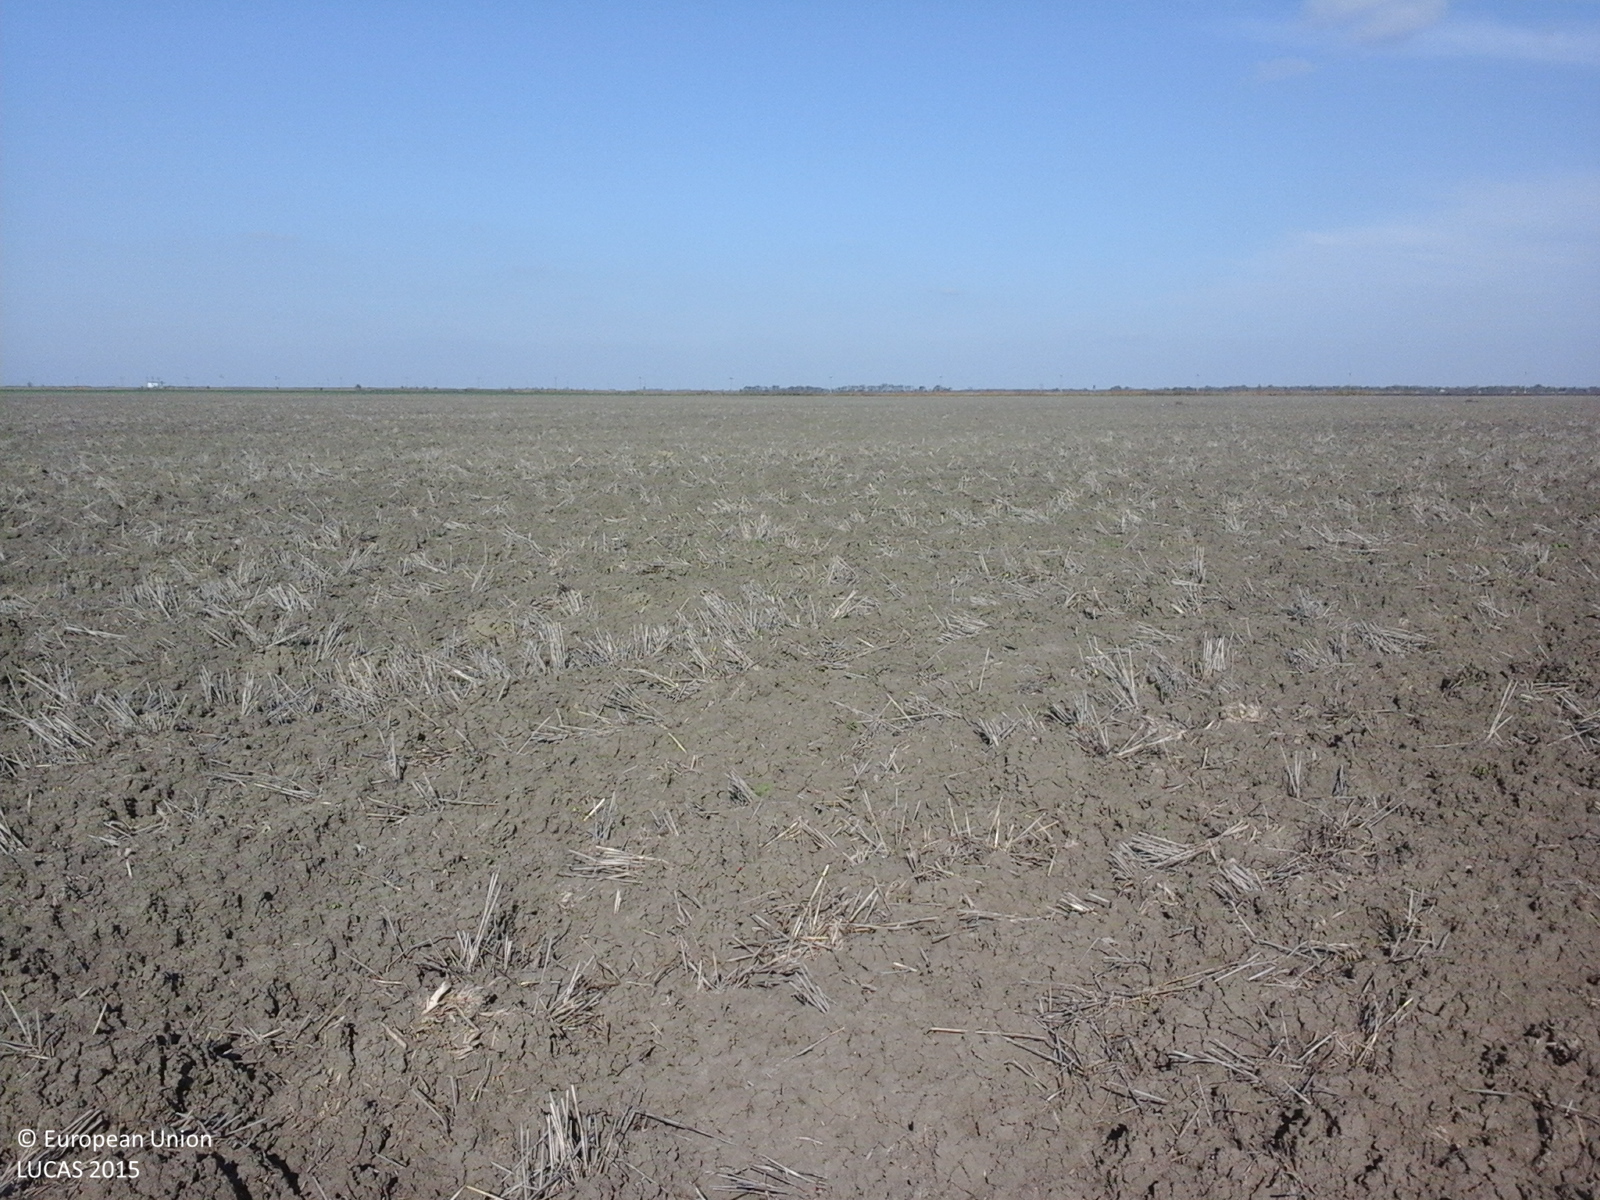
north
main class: Cropland
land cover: Durum wheat
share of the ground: > 75 %
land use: Agriculture (excluding fallow land and kitchen gardens)
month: October
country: RO
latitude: 45.4410
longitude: 27.4222
